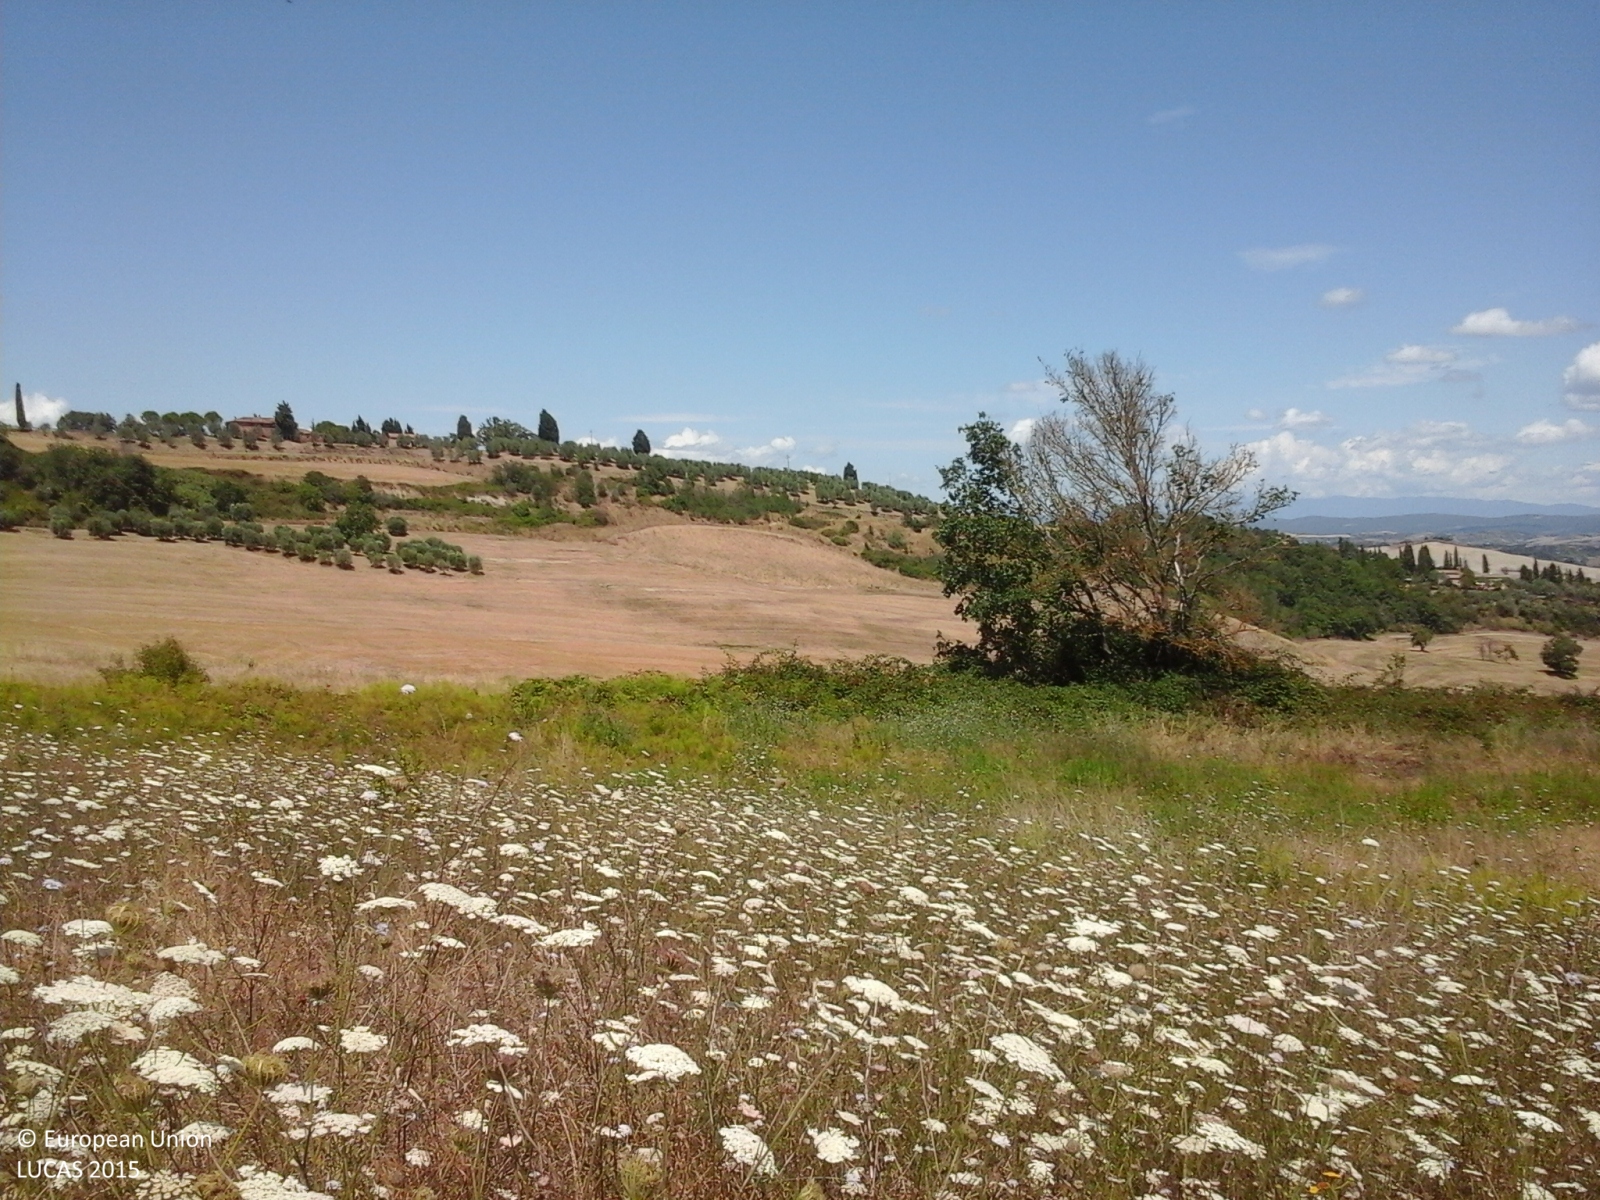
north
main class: Grassland
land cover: Grassland without tree/shrub cover
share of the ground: > 75 %
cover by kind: herbaceous plants 100 %
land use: Agriculture (excluding fallow land and kitchen gardens)
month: August
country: IT
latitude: 43.1838
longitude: 11.5579
